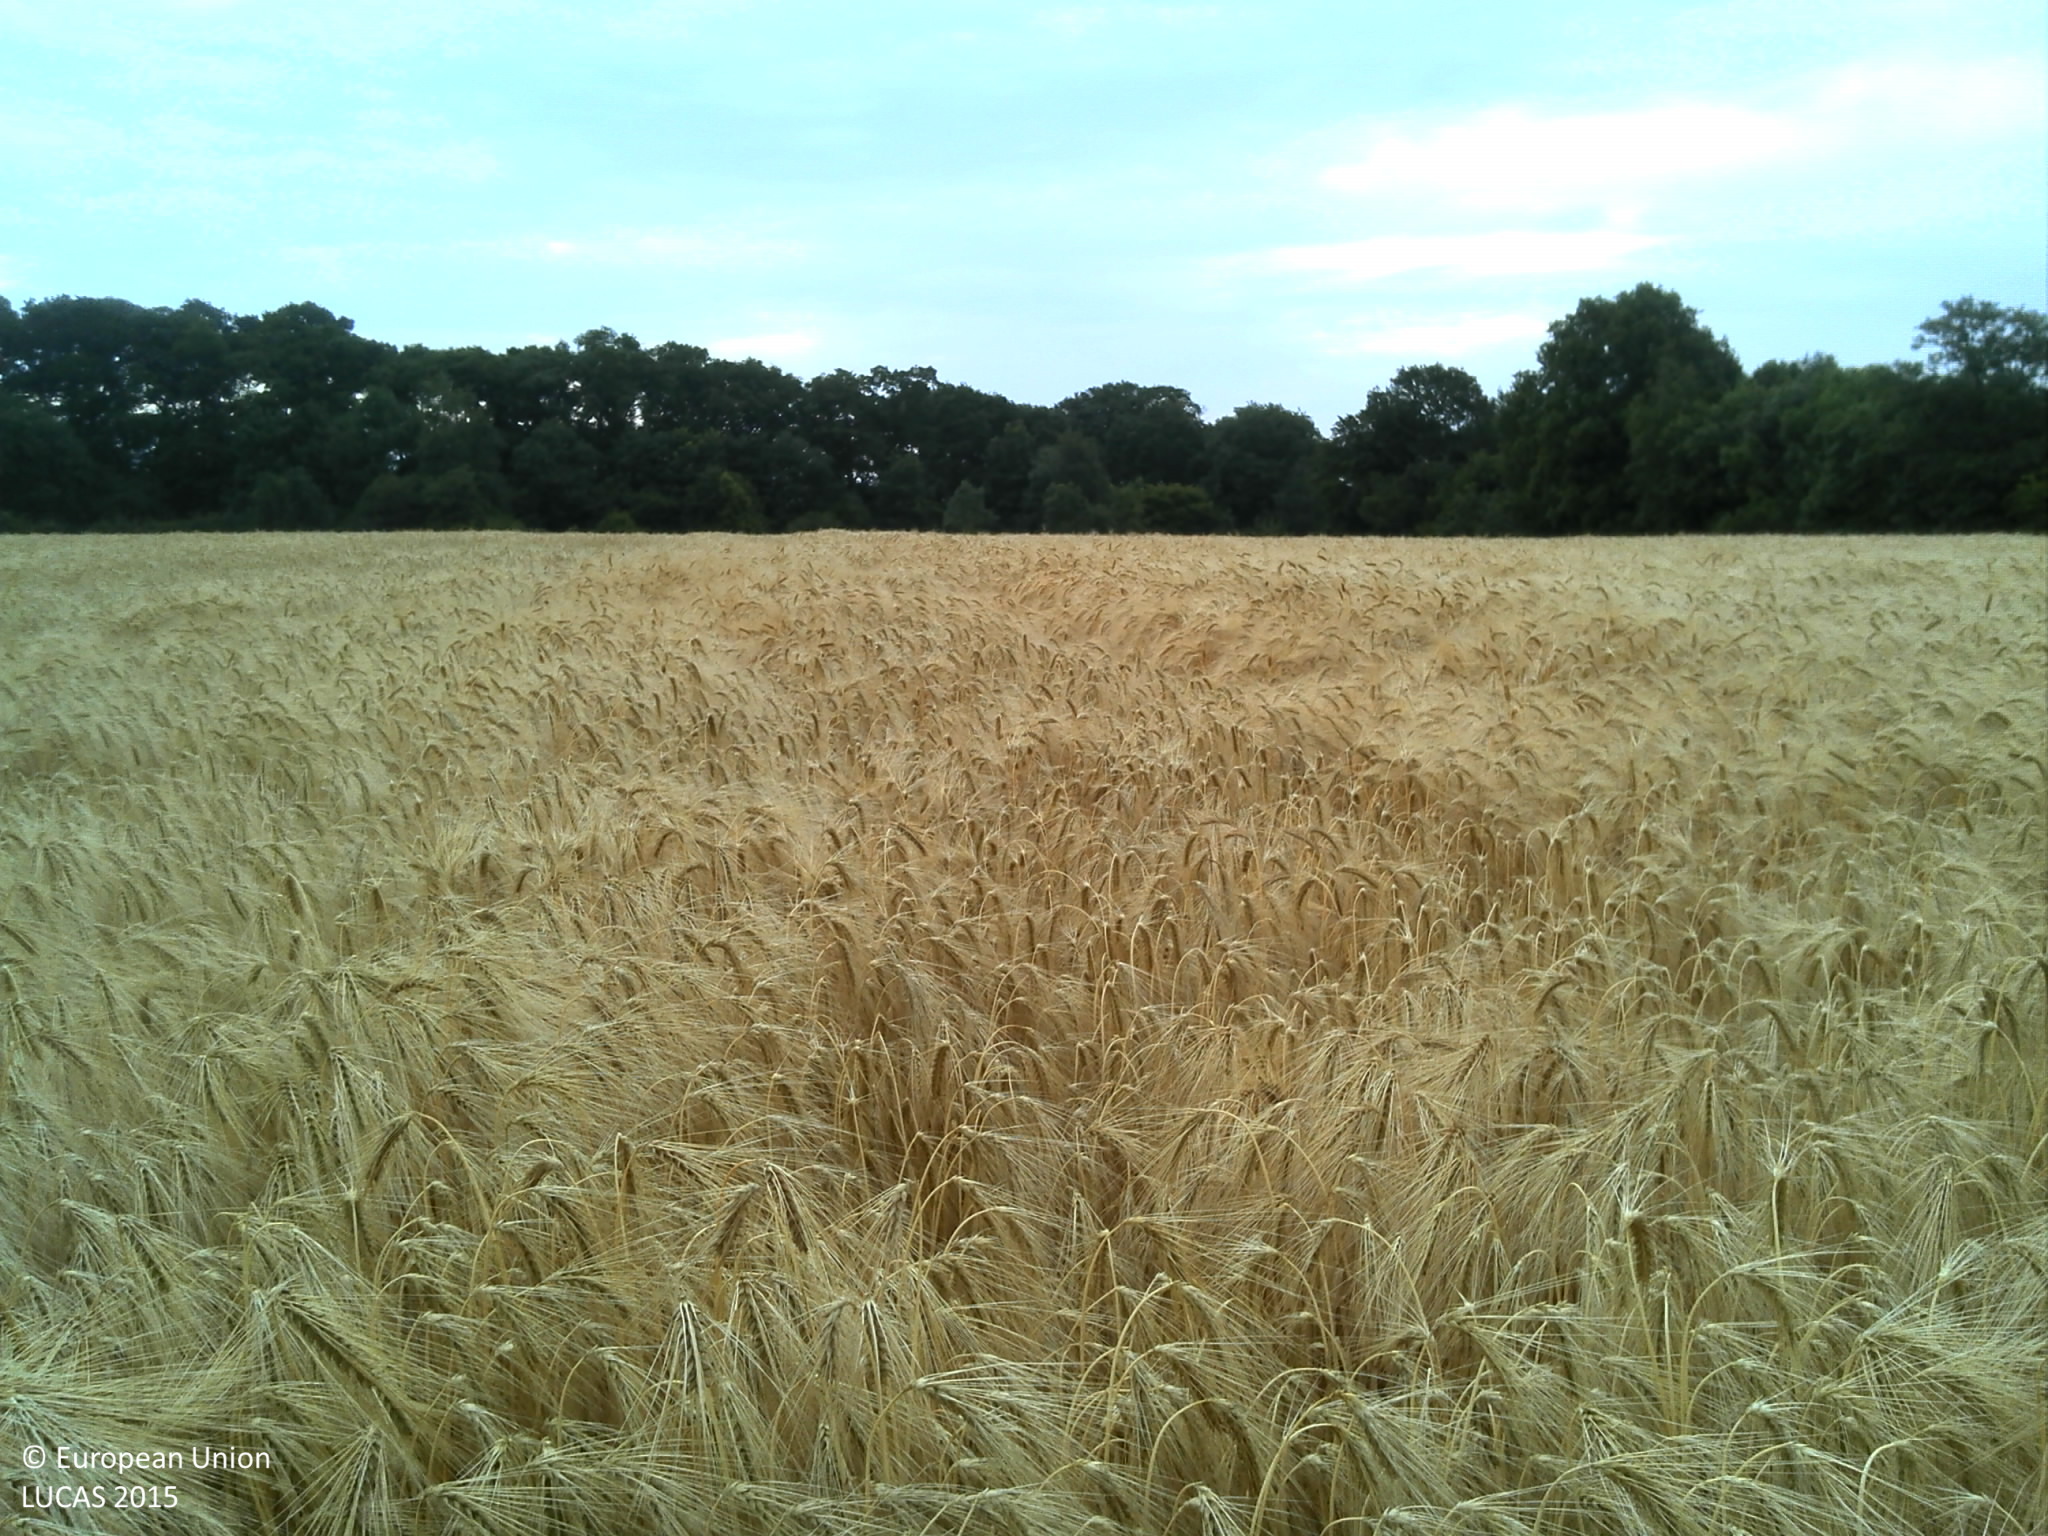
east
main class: Cropland
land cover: Barley
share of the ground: > 75 %
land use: Agriculture (excluding fallow land and kitchen gardens)
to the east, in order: Barley; Grassland with sparse tree/shrub cover; Broadleaved woodland; Paved roads, cycling and walking lanes; Broadleaved woodland; Grassland without tree/shrub cover
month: July
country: FR
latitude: 49.8999
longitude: 0.9975
